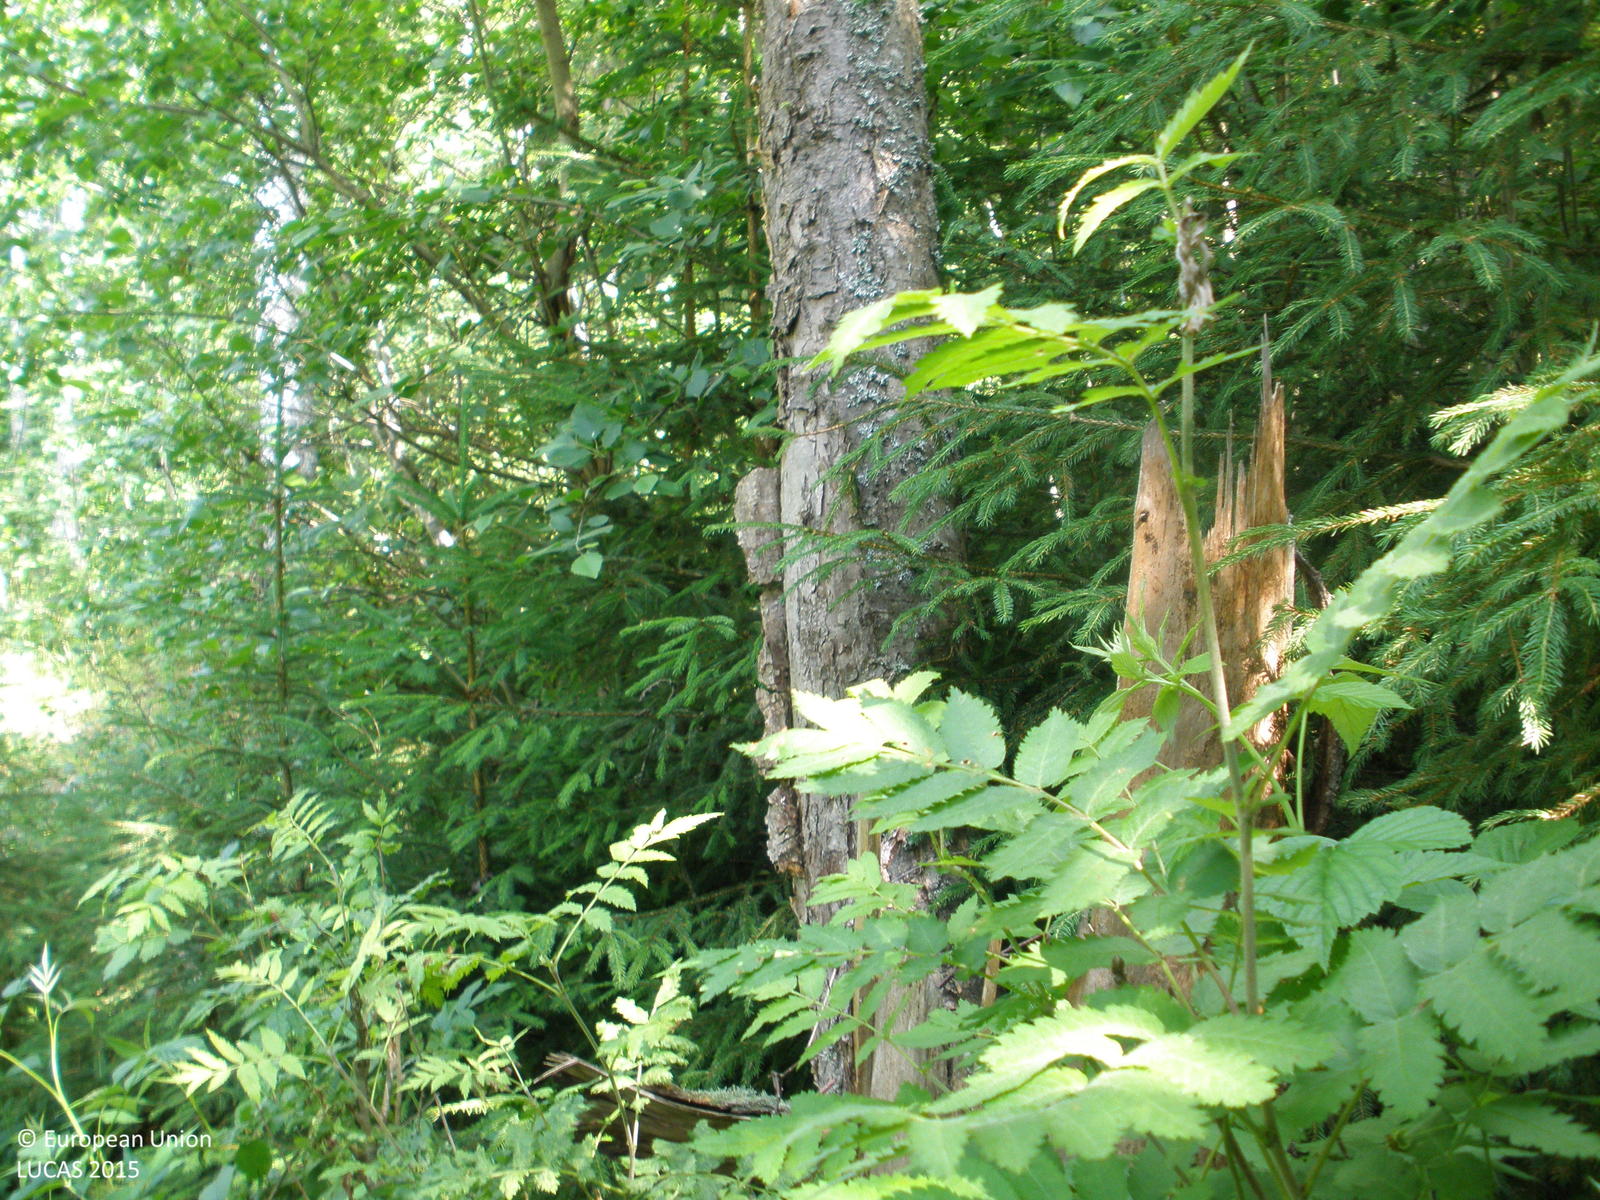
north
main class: Woodland
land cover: Spruce dominated mixed woodland
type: boreal forest
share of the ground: 50 - 75 %
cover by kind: broadleaved forest trees 35 %, coniferous forest trees 30 %, herbaceous plants 25 %, shrubs 10 %
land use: Forestry
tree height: > 5 m
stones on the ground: < 10 %
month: July
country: FI
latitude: 61.2654
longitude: 23.9057
